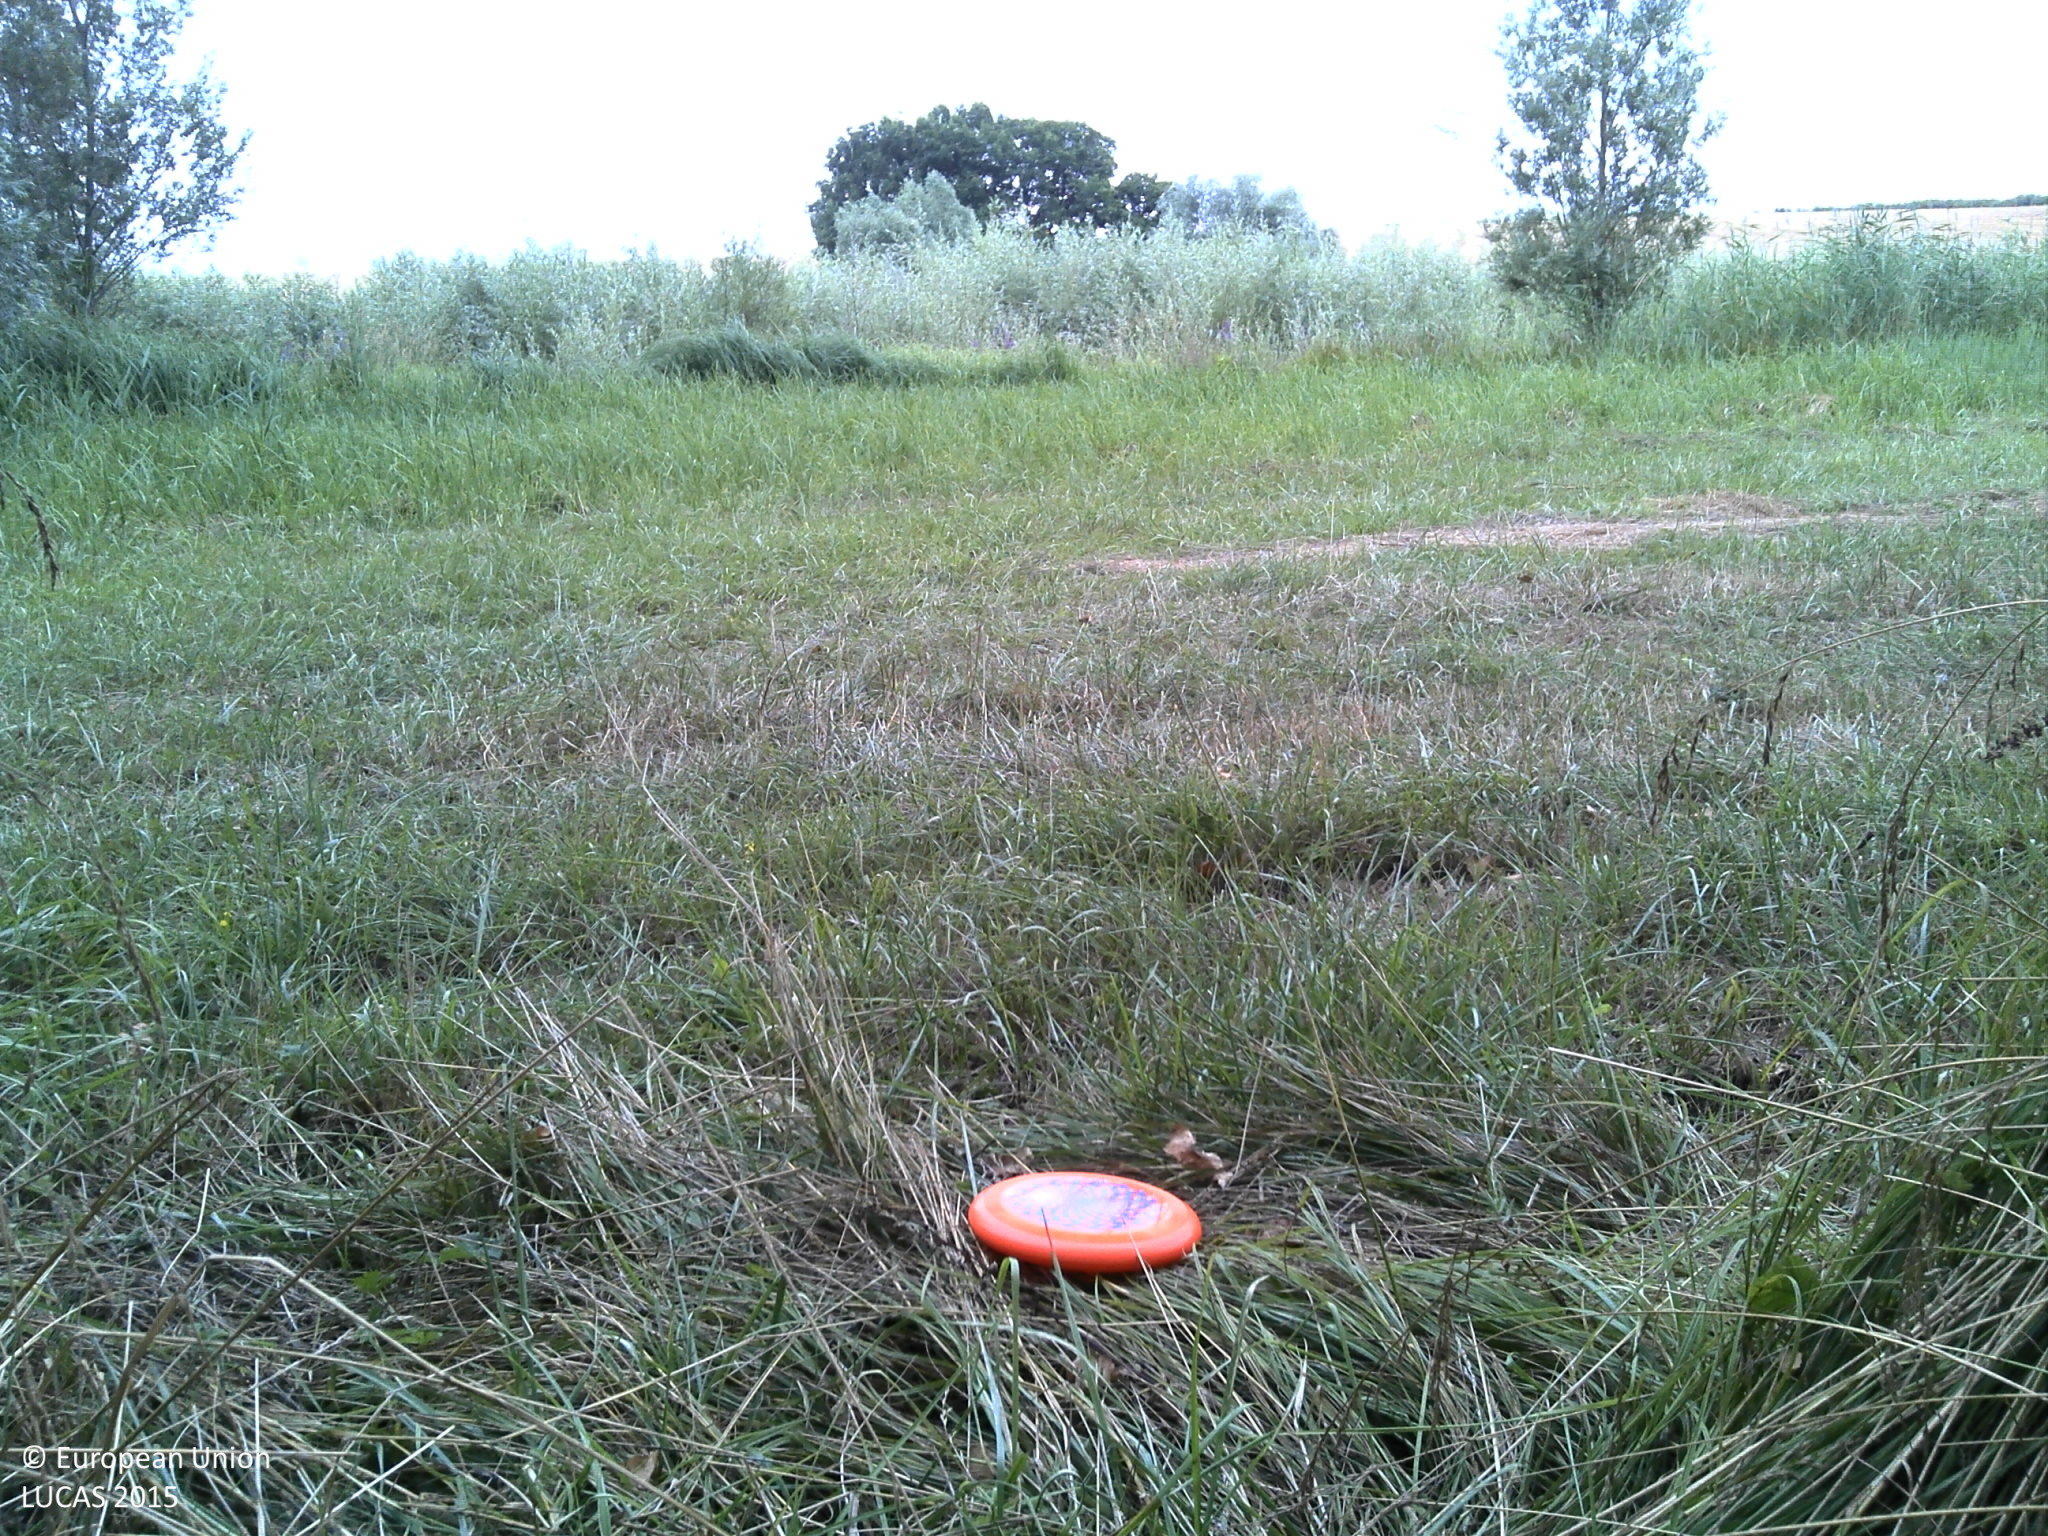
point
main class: Grassland
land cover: Grassland with sparse tree/shrub cover
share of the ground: > 75 %
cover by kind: herbaceous plants 95 %, broadleaved forest trees 5 %
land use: Agriculture (excluding fallow land and kitchen gardens)
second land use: Amenities, museums, leisure
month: July
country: FR
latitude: 48.5776
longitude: 4.5891
